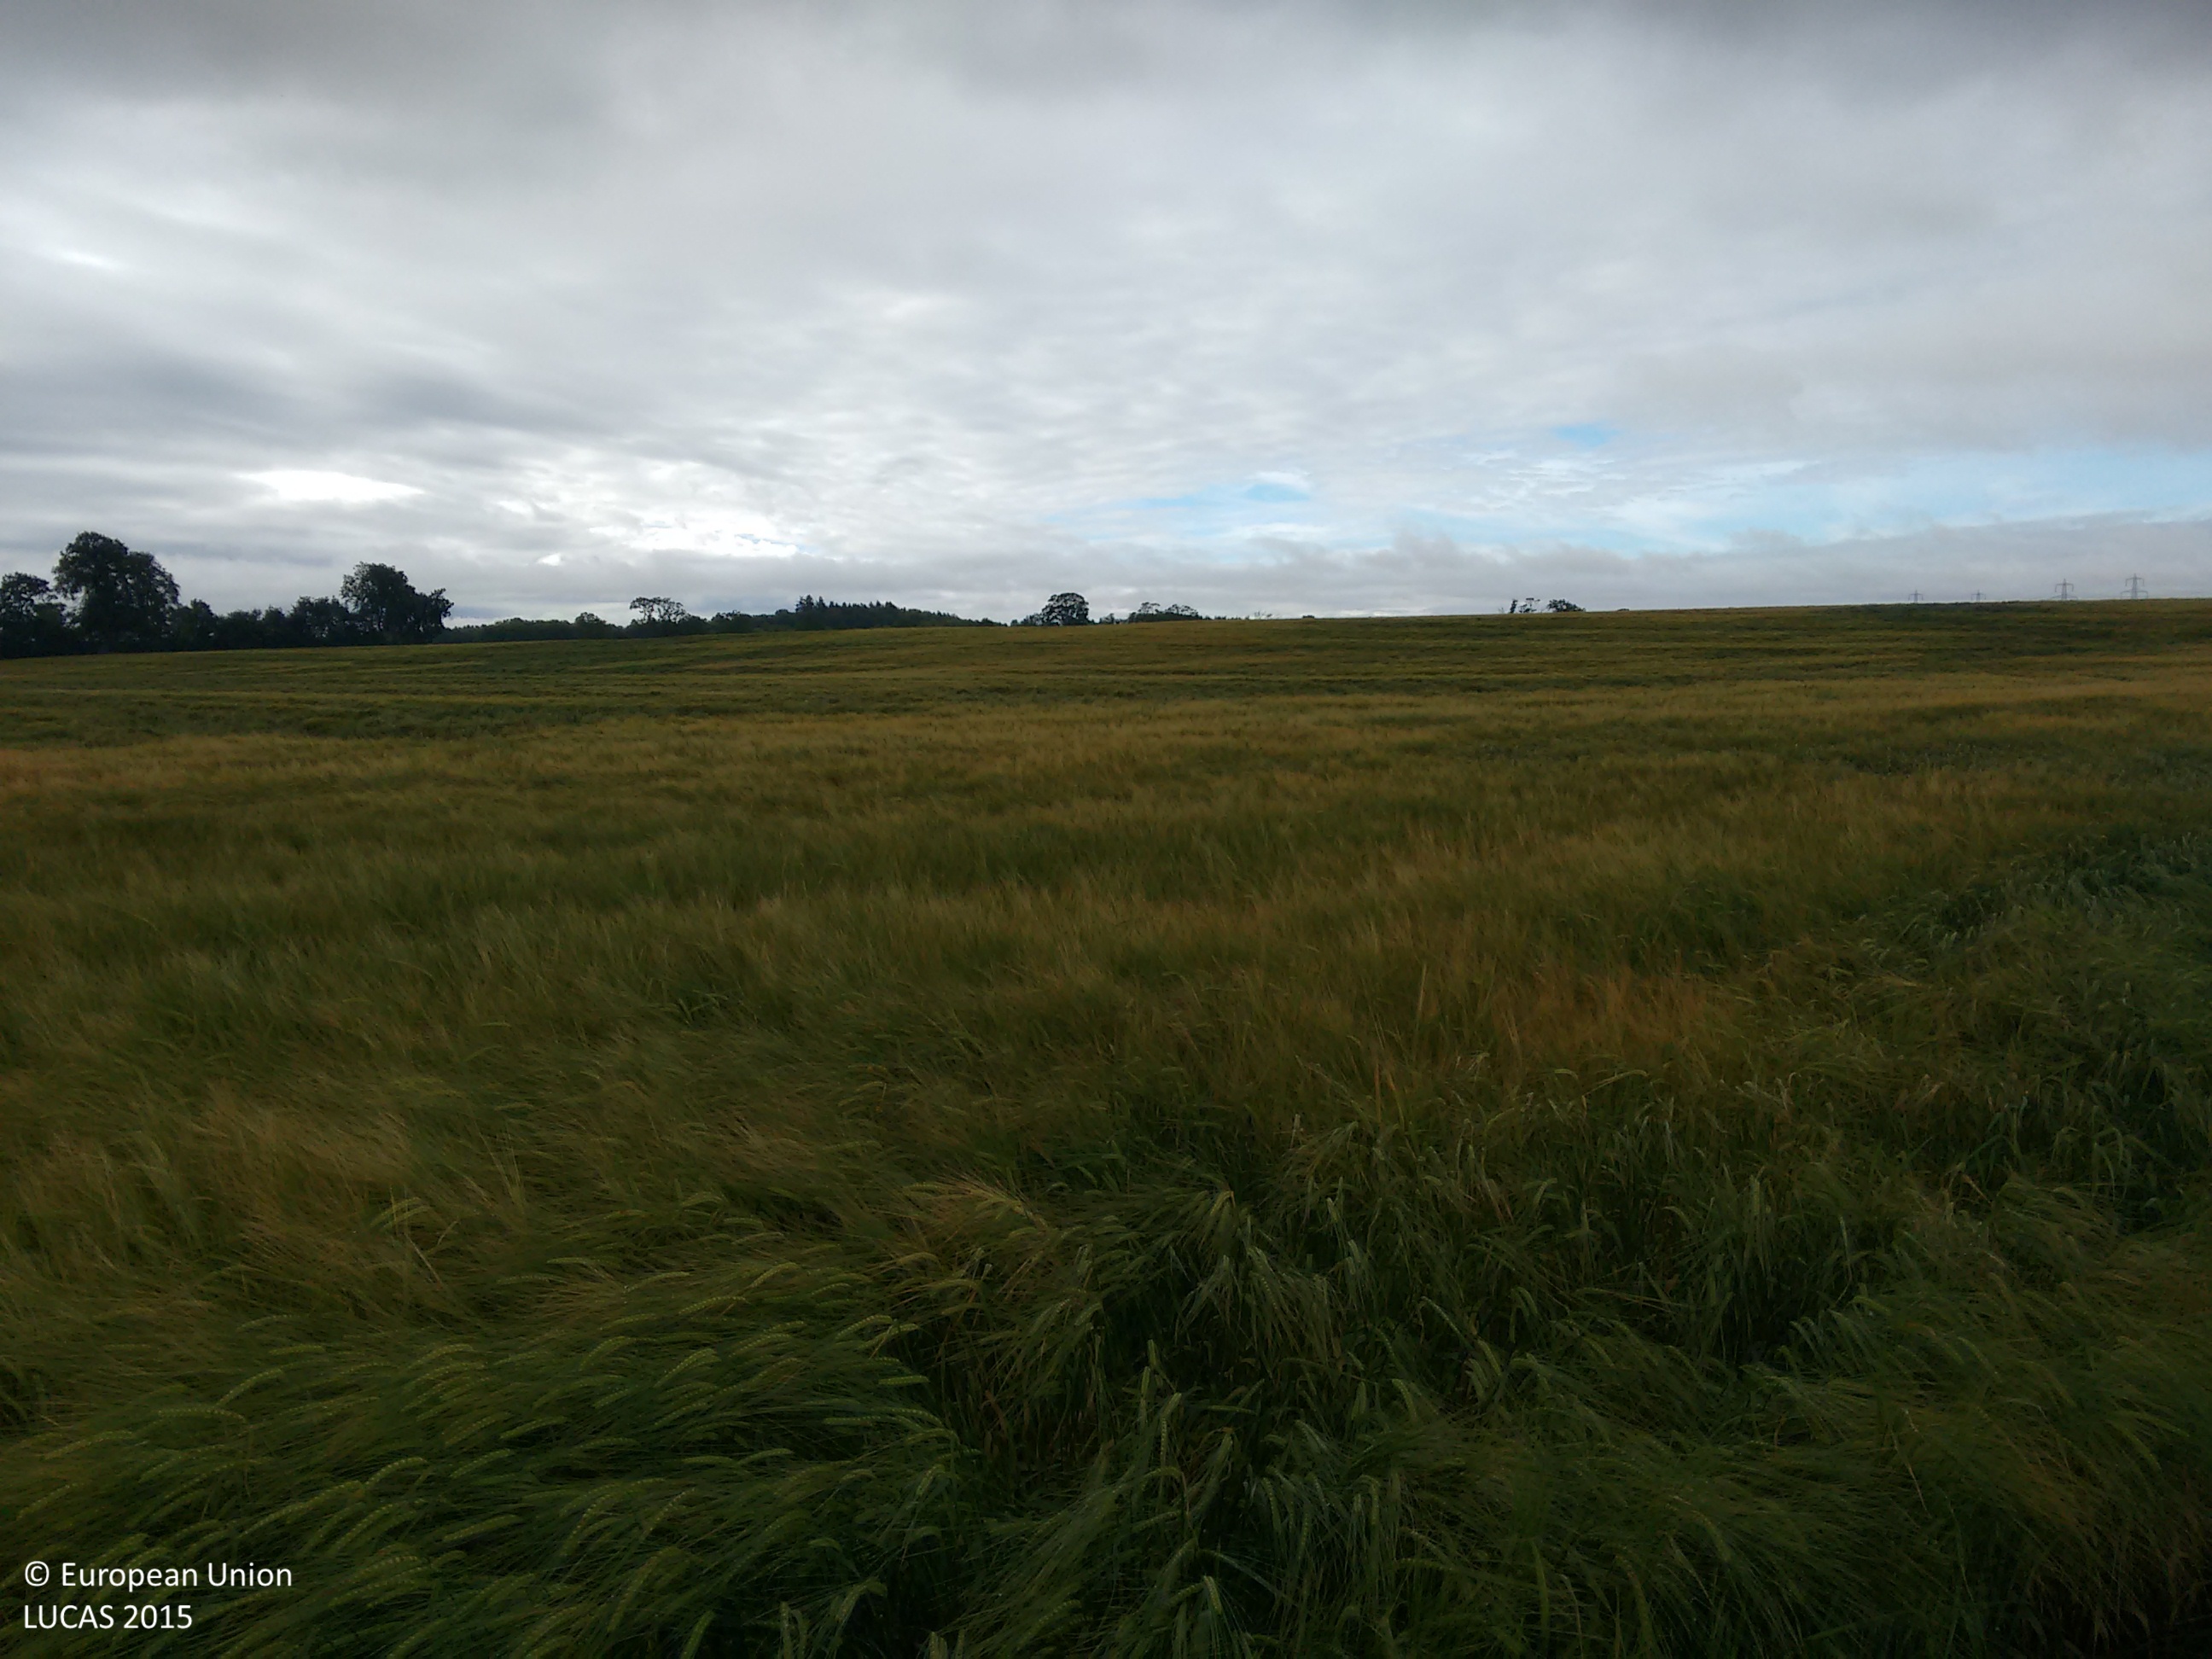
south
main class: Cropland
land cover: Barley
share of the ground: > 75 %
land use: Agriculture (excluding fallow land and kitchen gardens)
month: August
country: GB
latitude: 56.0957
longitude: -3.7942
